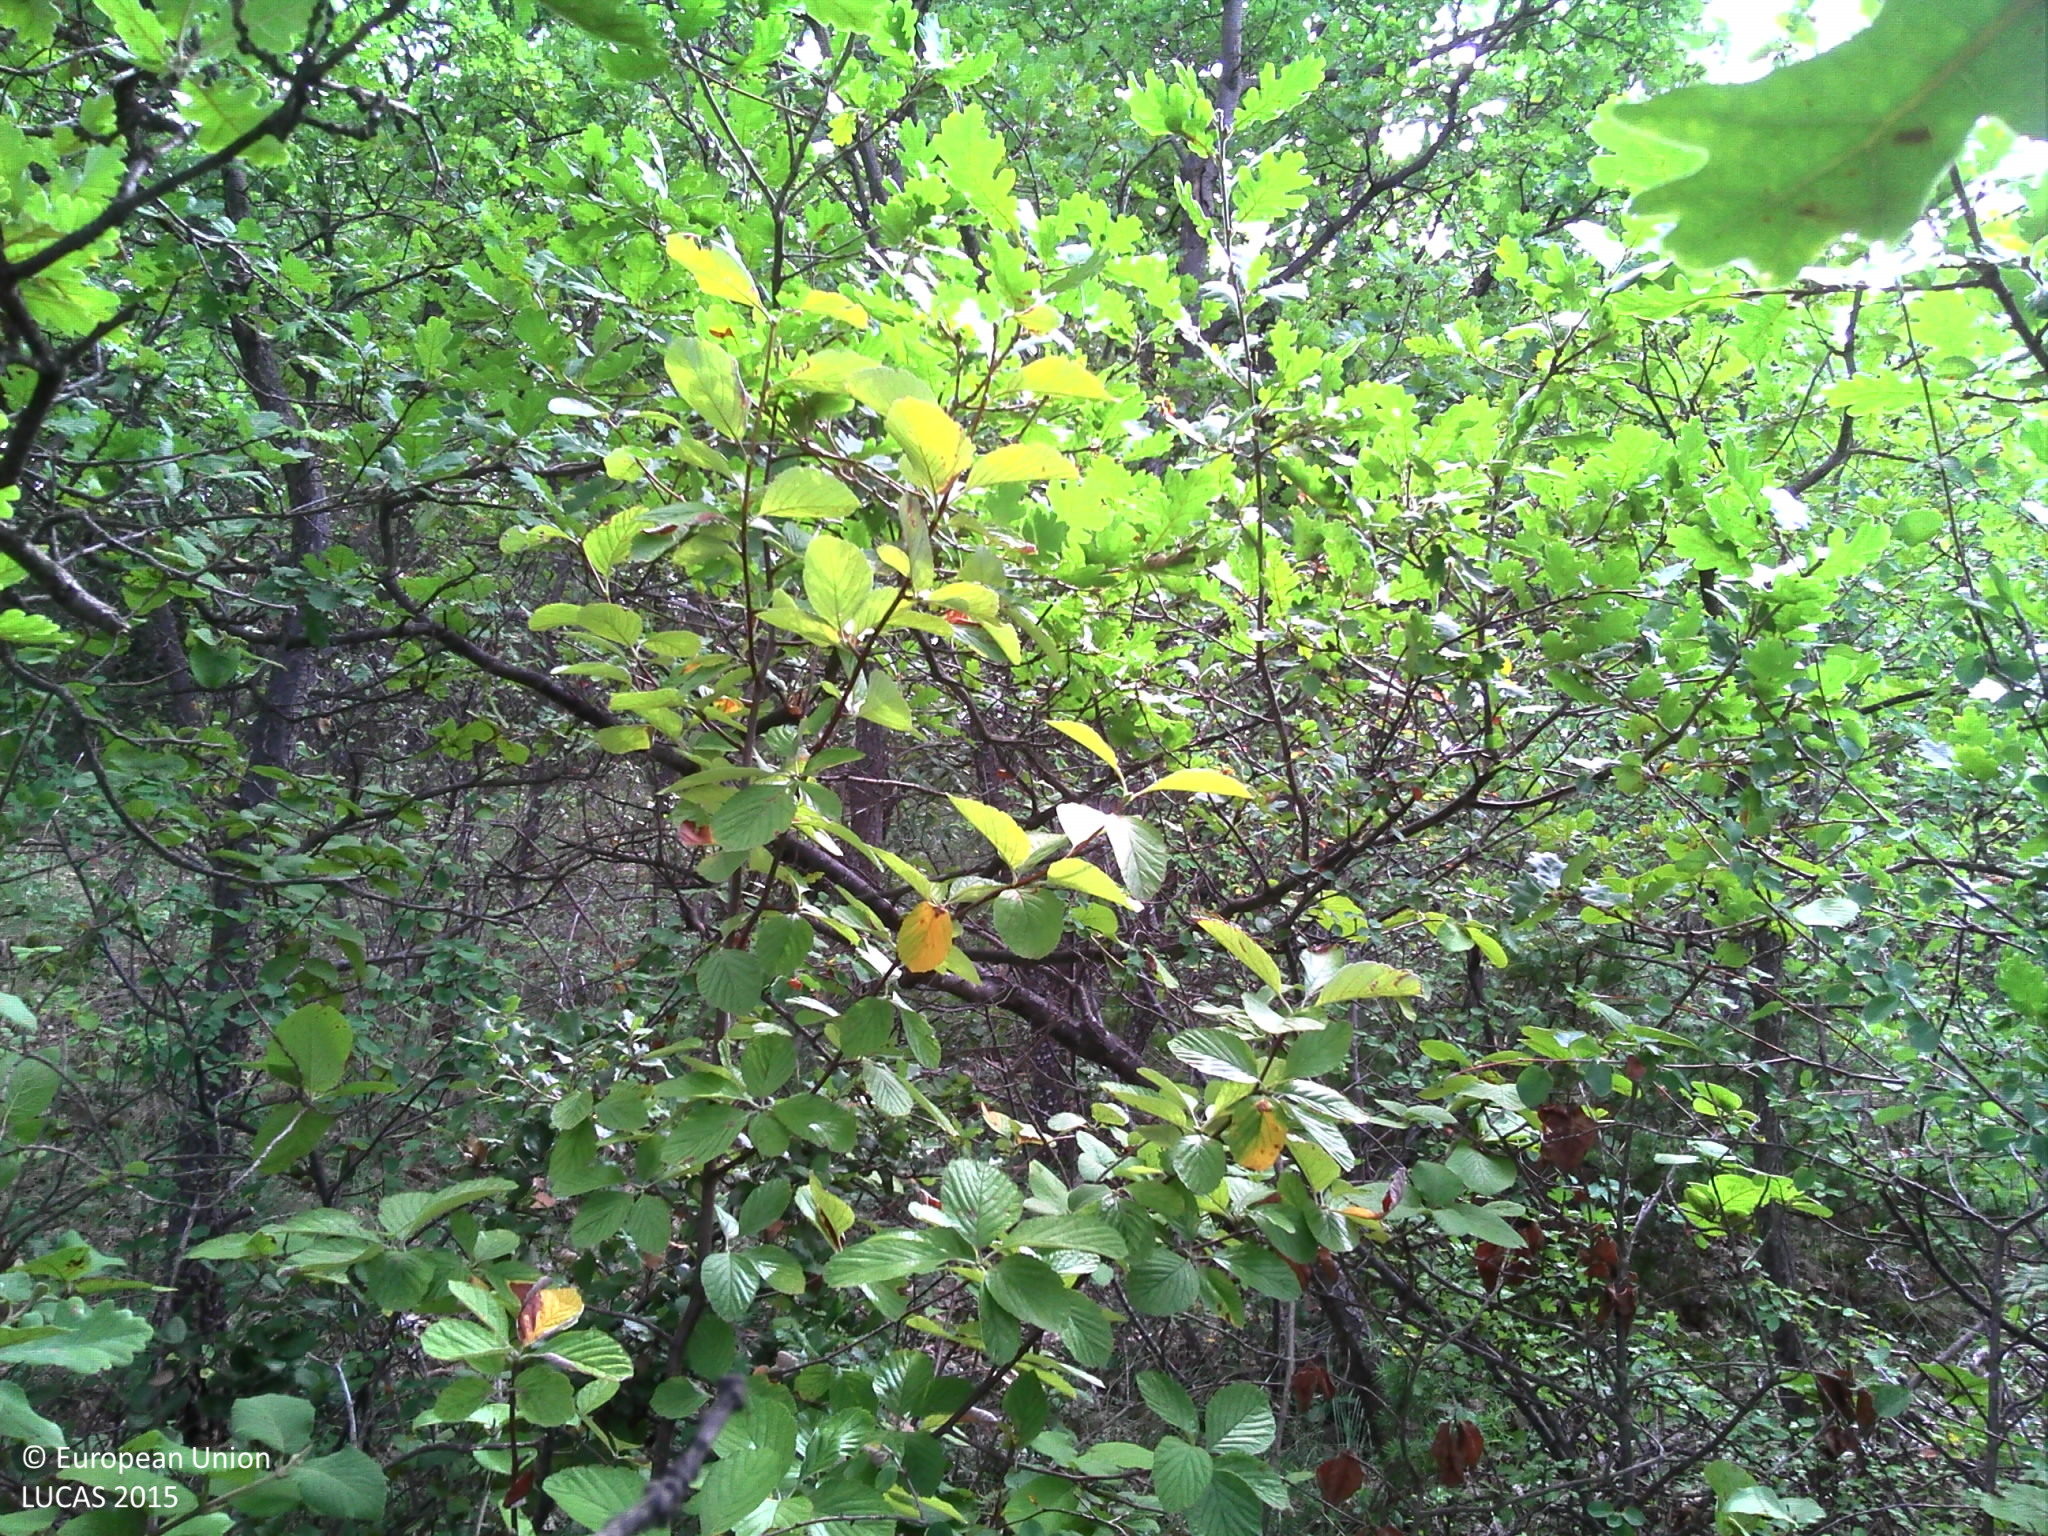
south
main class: Woodland
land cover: Pine dominated mixed woodland
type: coniferous forest of the mediterranean region
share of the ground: > 75 %
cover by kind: broadleaved forest trees 55 %, coniferous forest trees 25 %, shrubs 10 %, herbaceous plants 10 %
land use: Forestry
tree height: > 5 m
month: September
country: FR
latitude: 44.3398
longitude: 5.0280
